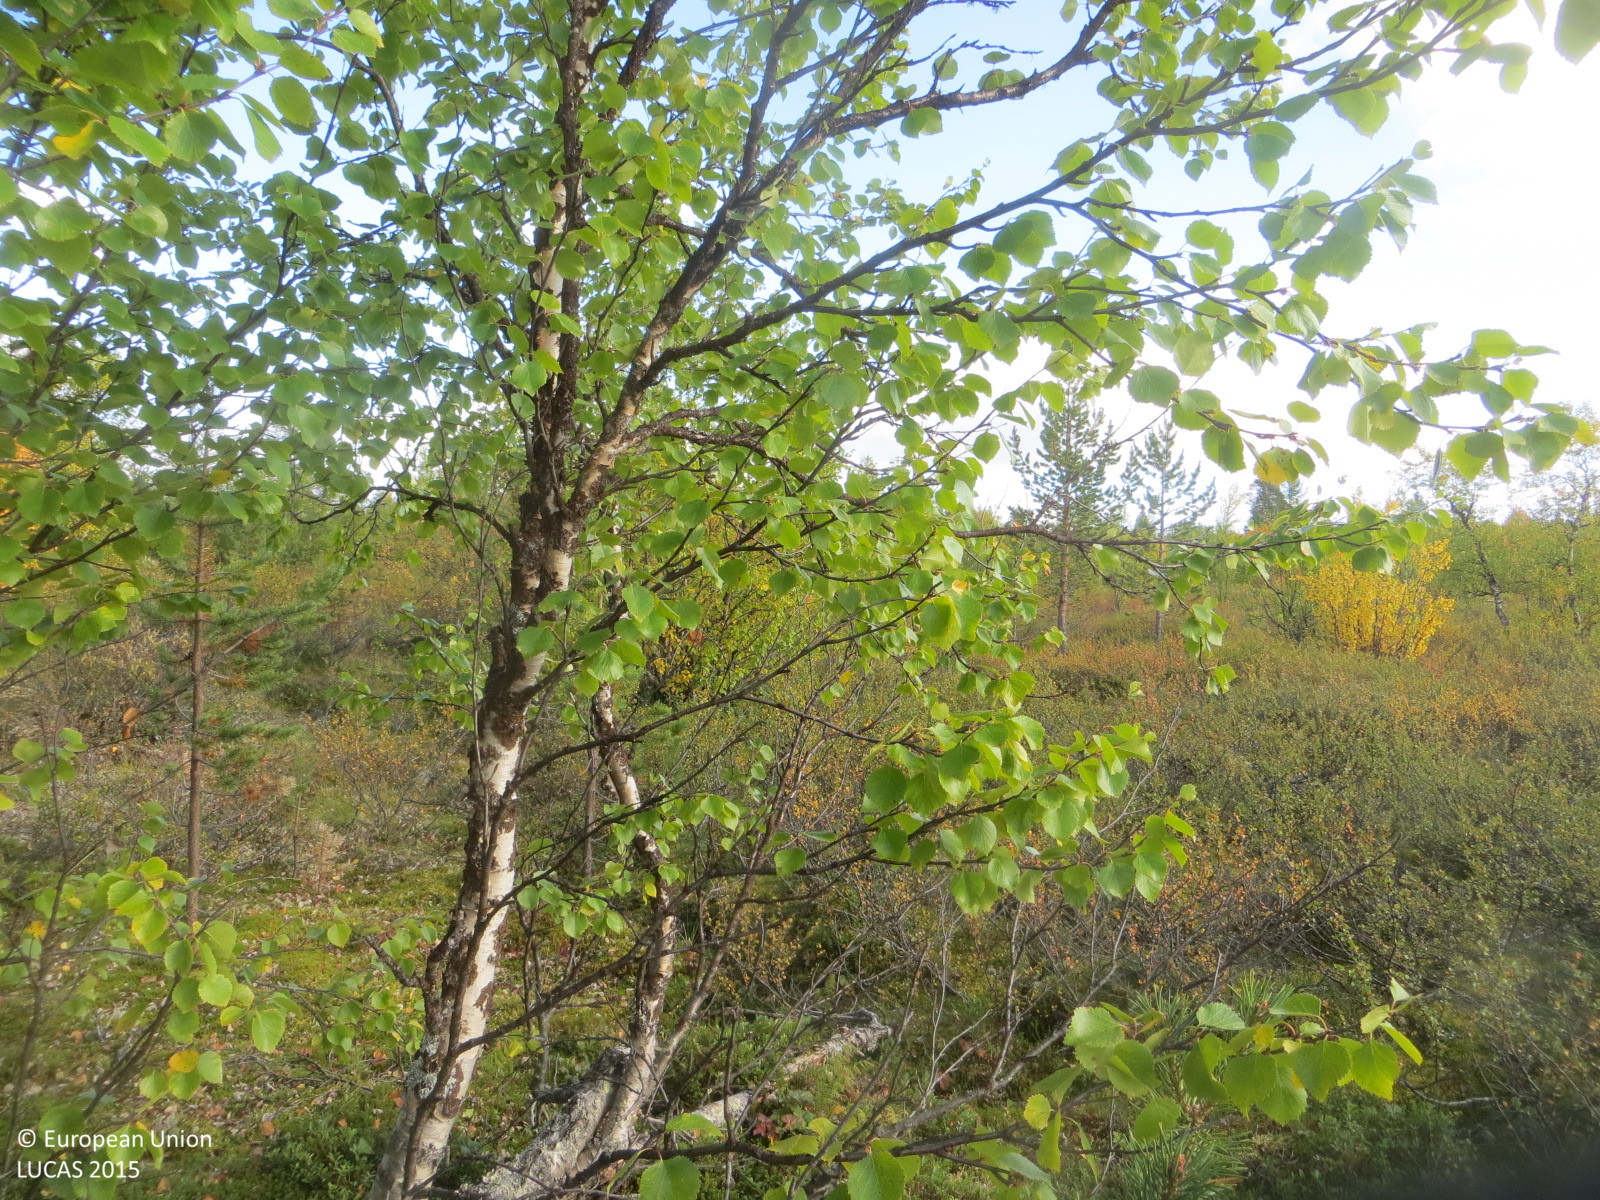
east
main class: Woodland
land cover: Pine dominated mixed woodland
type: boreal forest
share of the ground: 50 - 75 %
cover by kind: shrubs 50 %, broadleaved forest trees 35 %, coniferous forest trees 15 %
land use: Semi-natural and natural areas not in use
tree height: > 5 m
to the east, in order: Pine dominated mixed woodland; Broadleaved woodland; Shrubland with sparse tree cover; Pine dominated mixed woodland
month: September
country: FI
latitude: 68.3999
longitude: 24.3028
